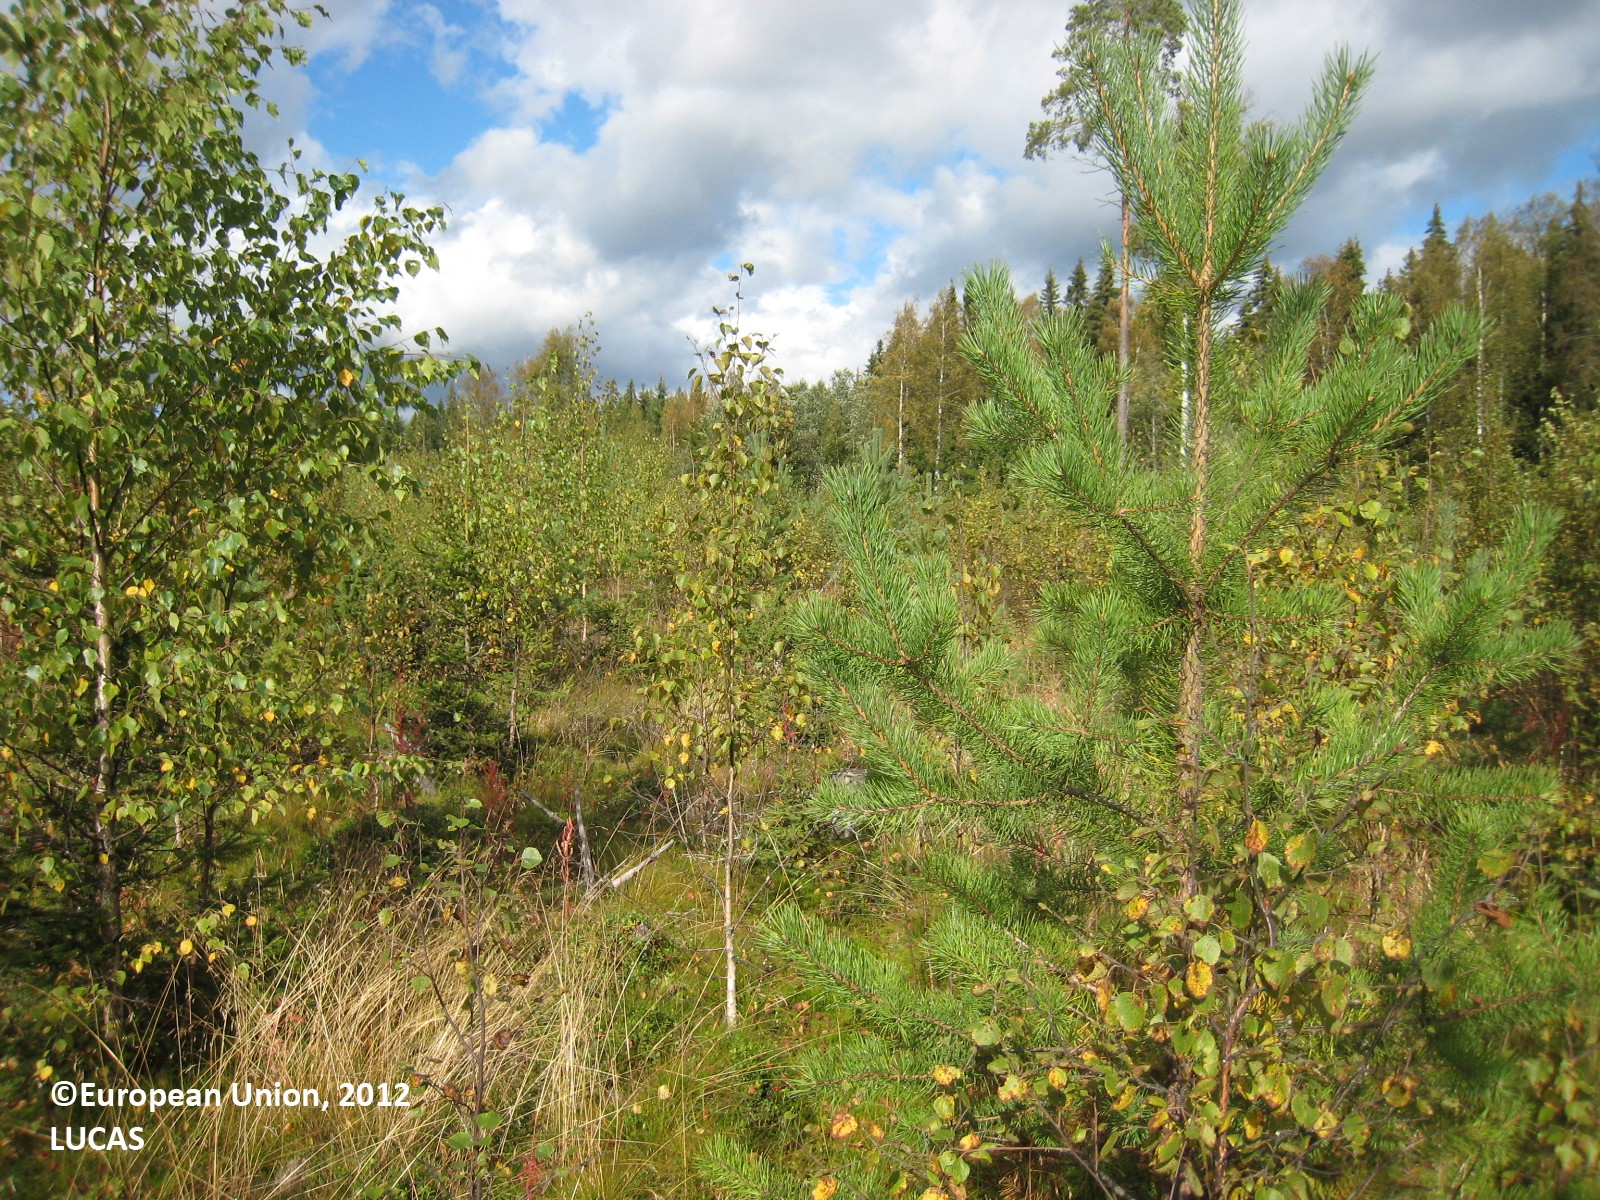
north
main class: Woodland
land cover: Other mixed woodland
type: boreal forest
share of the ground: 50 - 75 %
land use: Forestry
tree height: > 5 m
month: September
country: FI
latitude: 63.0370
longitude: 26.7240
